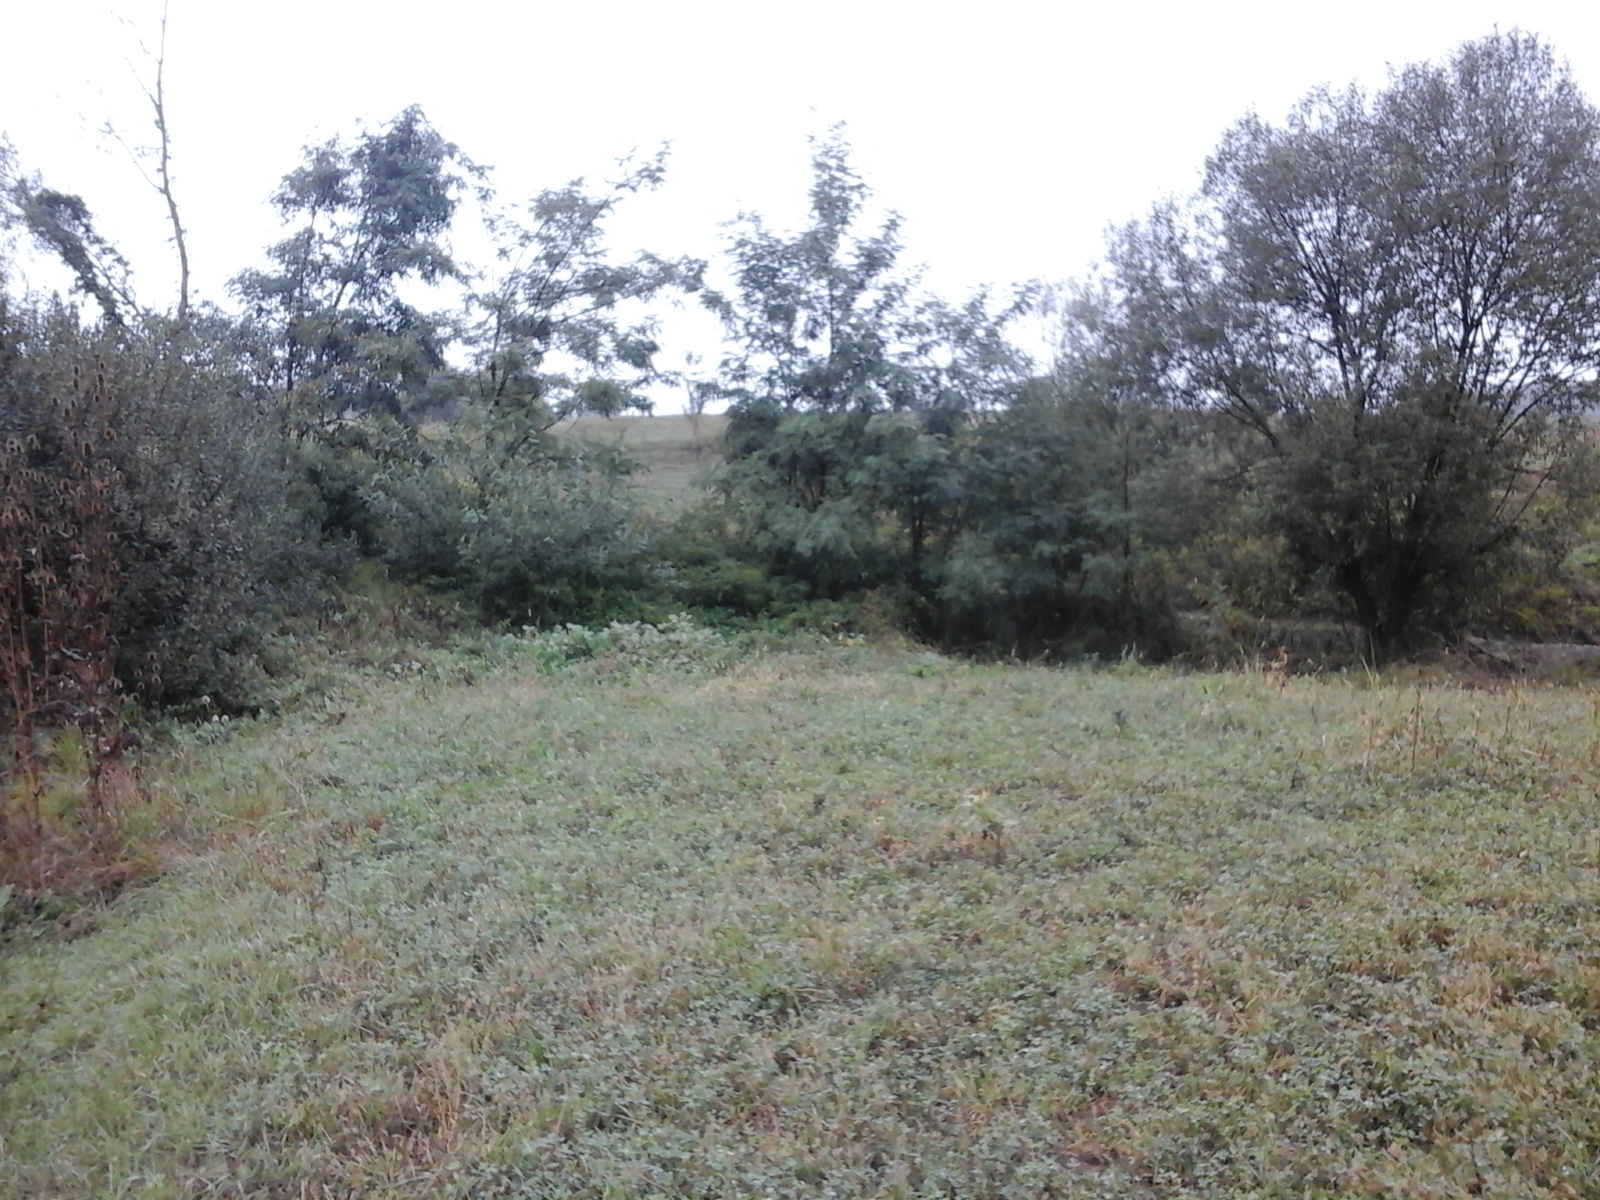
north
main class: Cropland
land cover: Other leguminous and mixtures for fodder
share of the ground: > 75 %
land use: Agriculture (excluding fallow land and kitchen gardens)
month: September
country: RO
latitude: 45.0324
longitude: 23.6544
